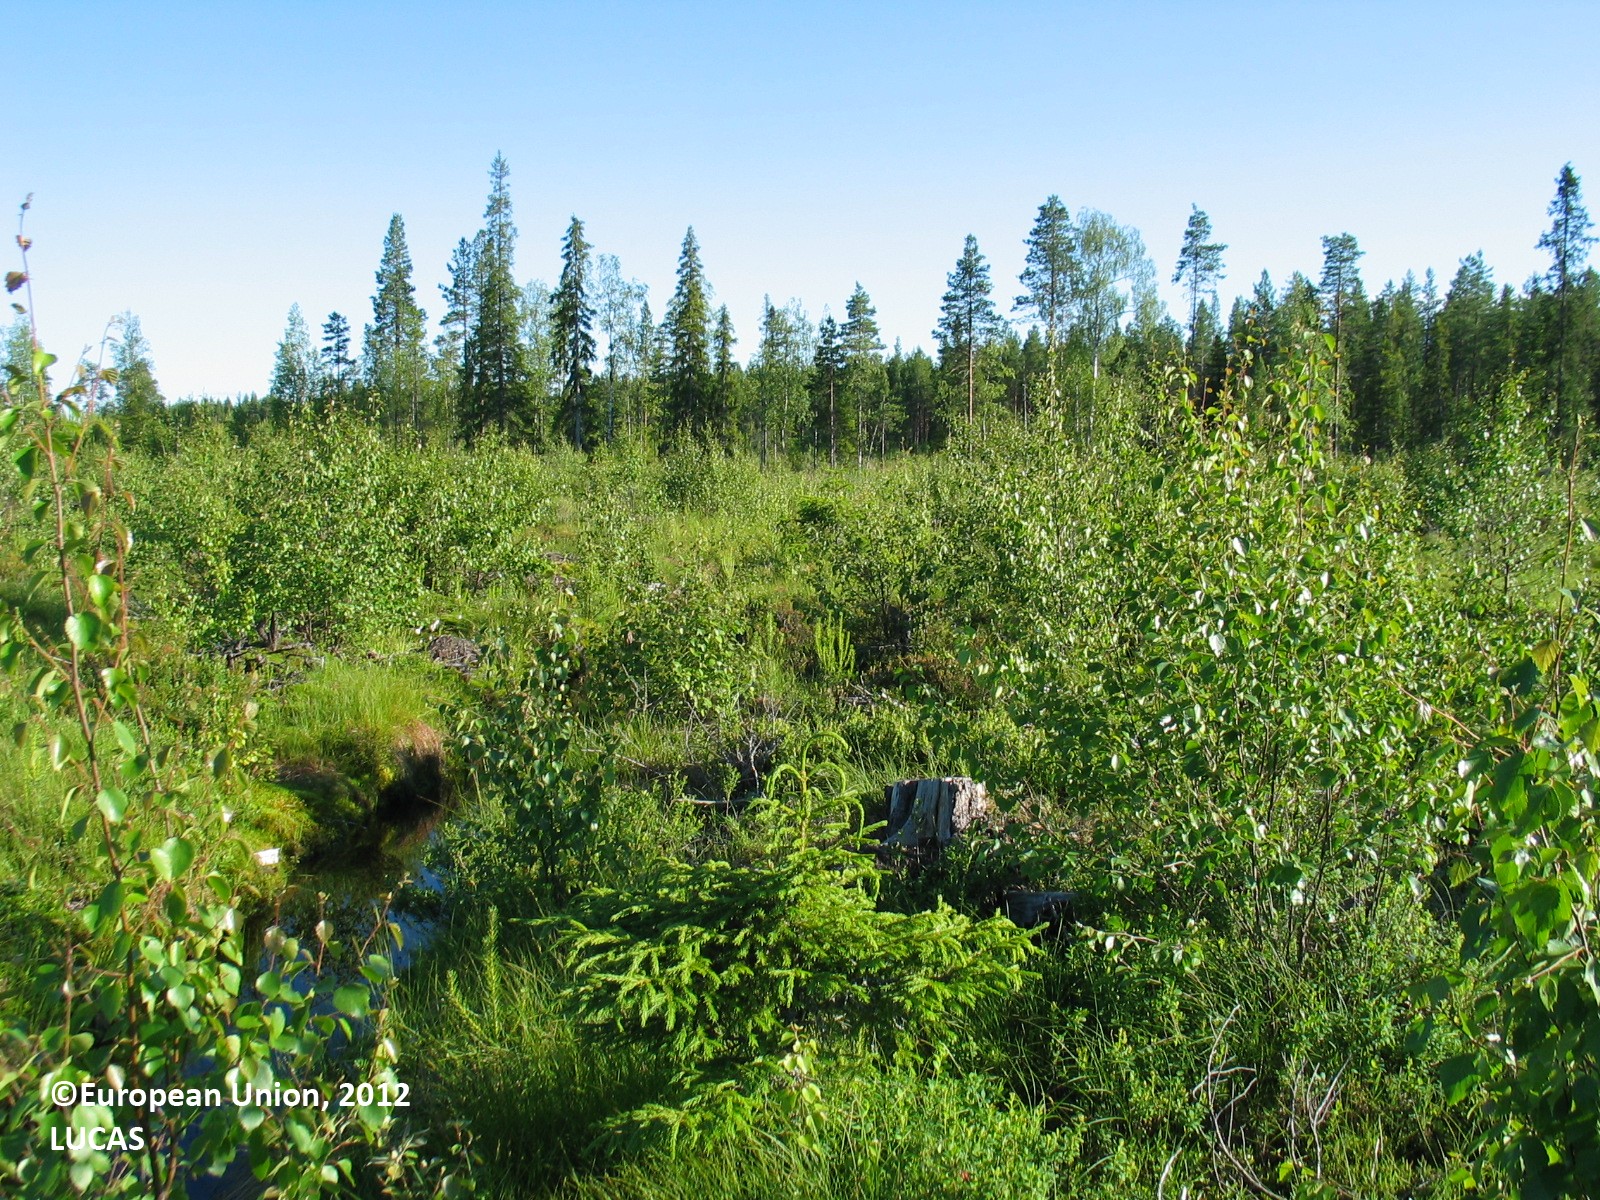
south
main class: Woodland
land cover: Other mixed woodland
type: boreal forest
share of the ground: 10 - 25 %
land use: Forestry
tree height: < 5 m
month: July
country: FI
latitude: 64.6865
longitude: 26.5687
